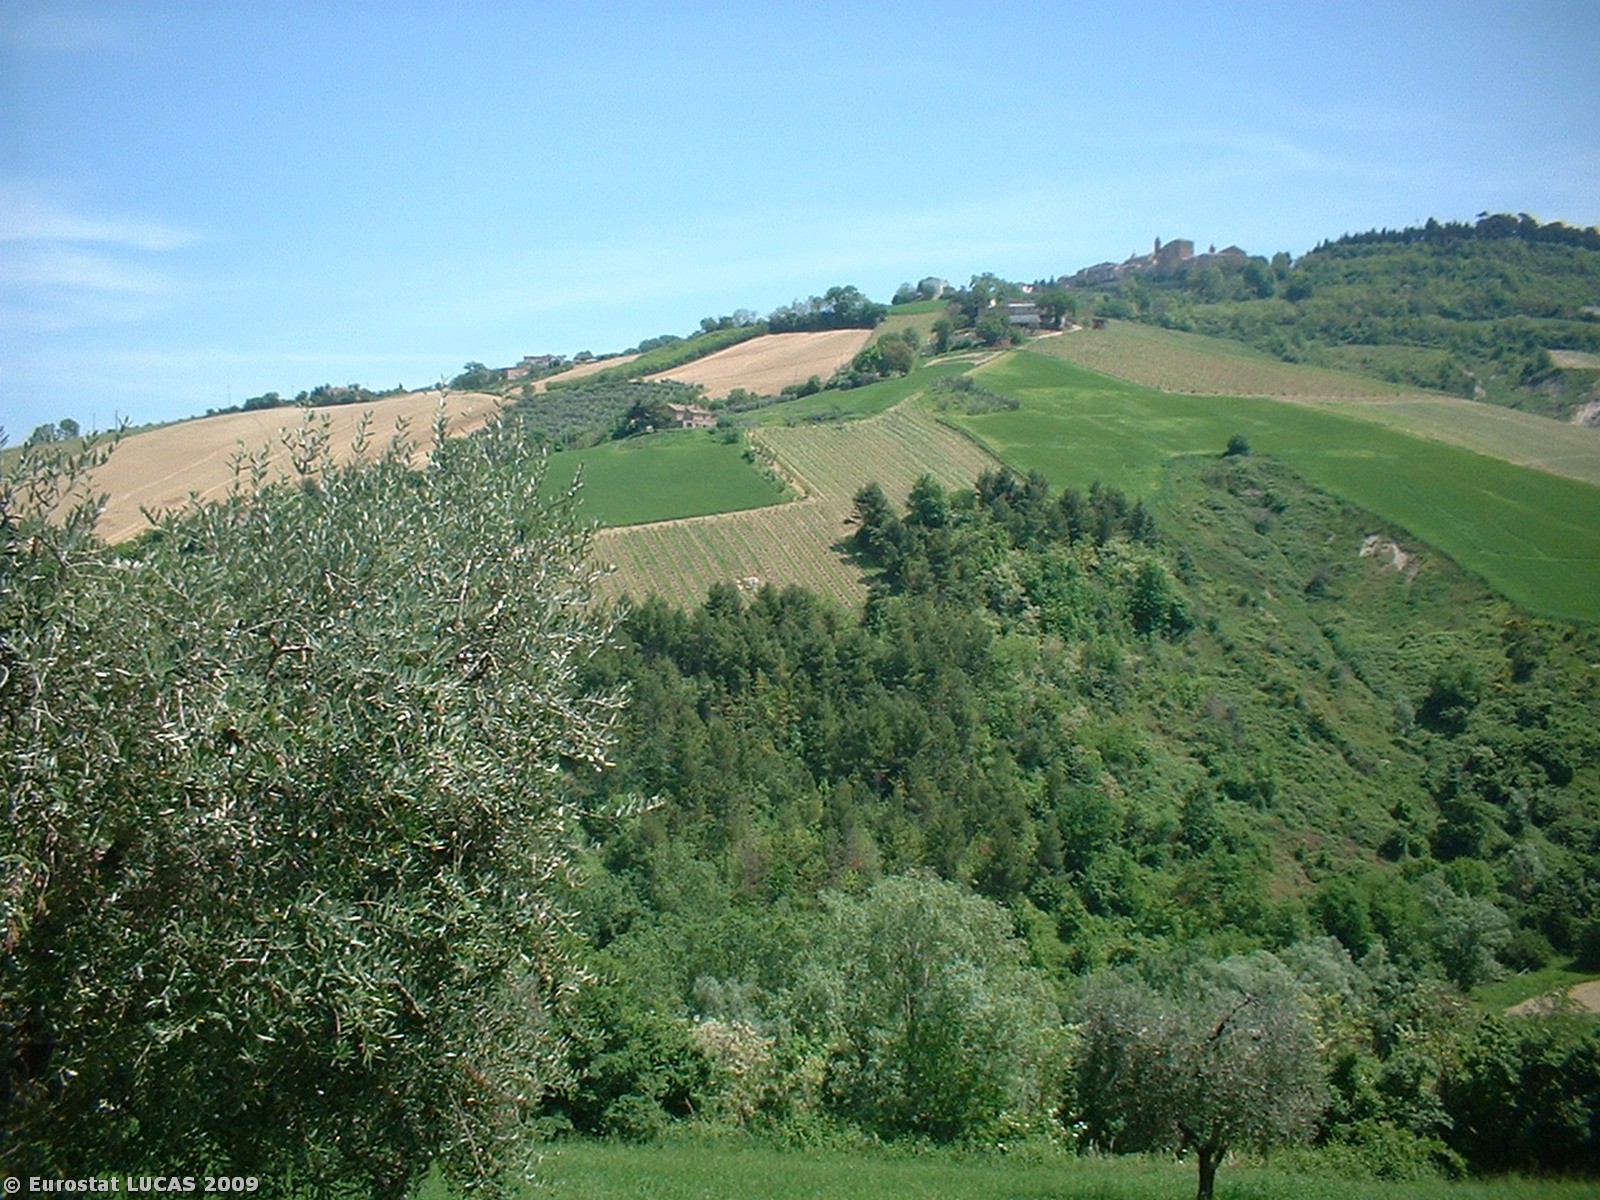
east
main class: Cropland
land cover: Olive groves
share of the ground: 10 - 25 %
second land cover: Grassland with sparse tree/shrub cover
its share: > 75 %
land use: Agriculture (excluding fallow land and kitchen gardens)
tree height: < 5 m
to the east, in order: Olive groves; Grassland with sparse tree/shrub cover; Shrubland with sparse tree cover; Paved roads, cycling and walking lanes; Shrubland with sparse tree cover; Durum wheat; Shrubland with sparse tree cover; Other structural elements; Ditches and canals; Broadleaved woodland
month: May
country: IT
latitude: 43.0551
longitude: 13.7348
